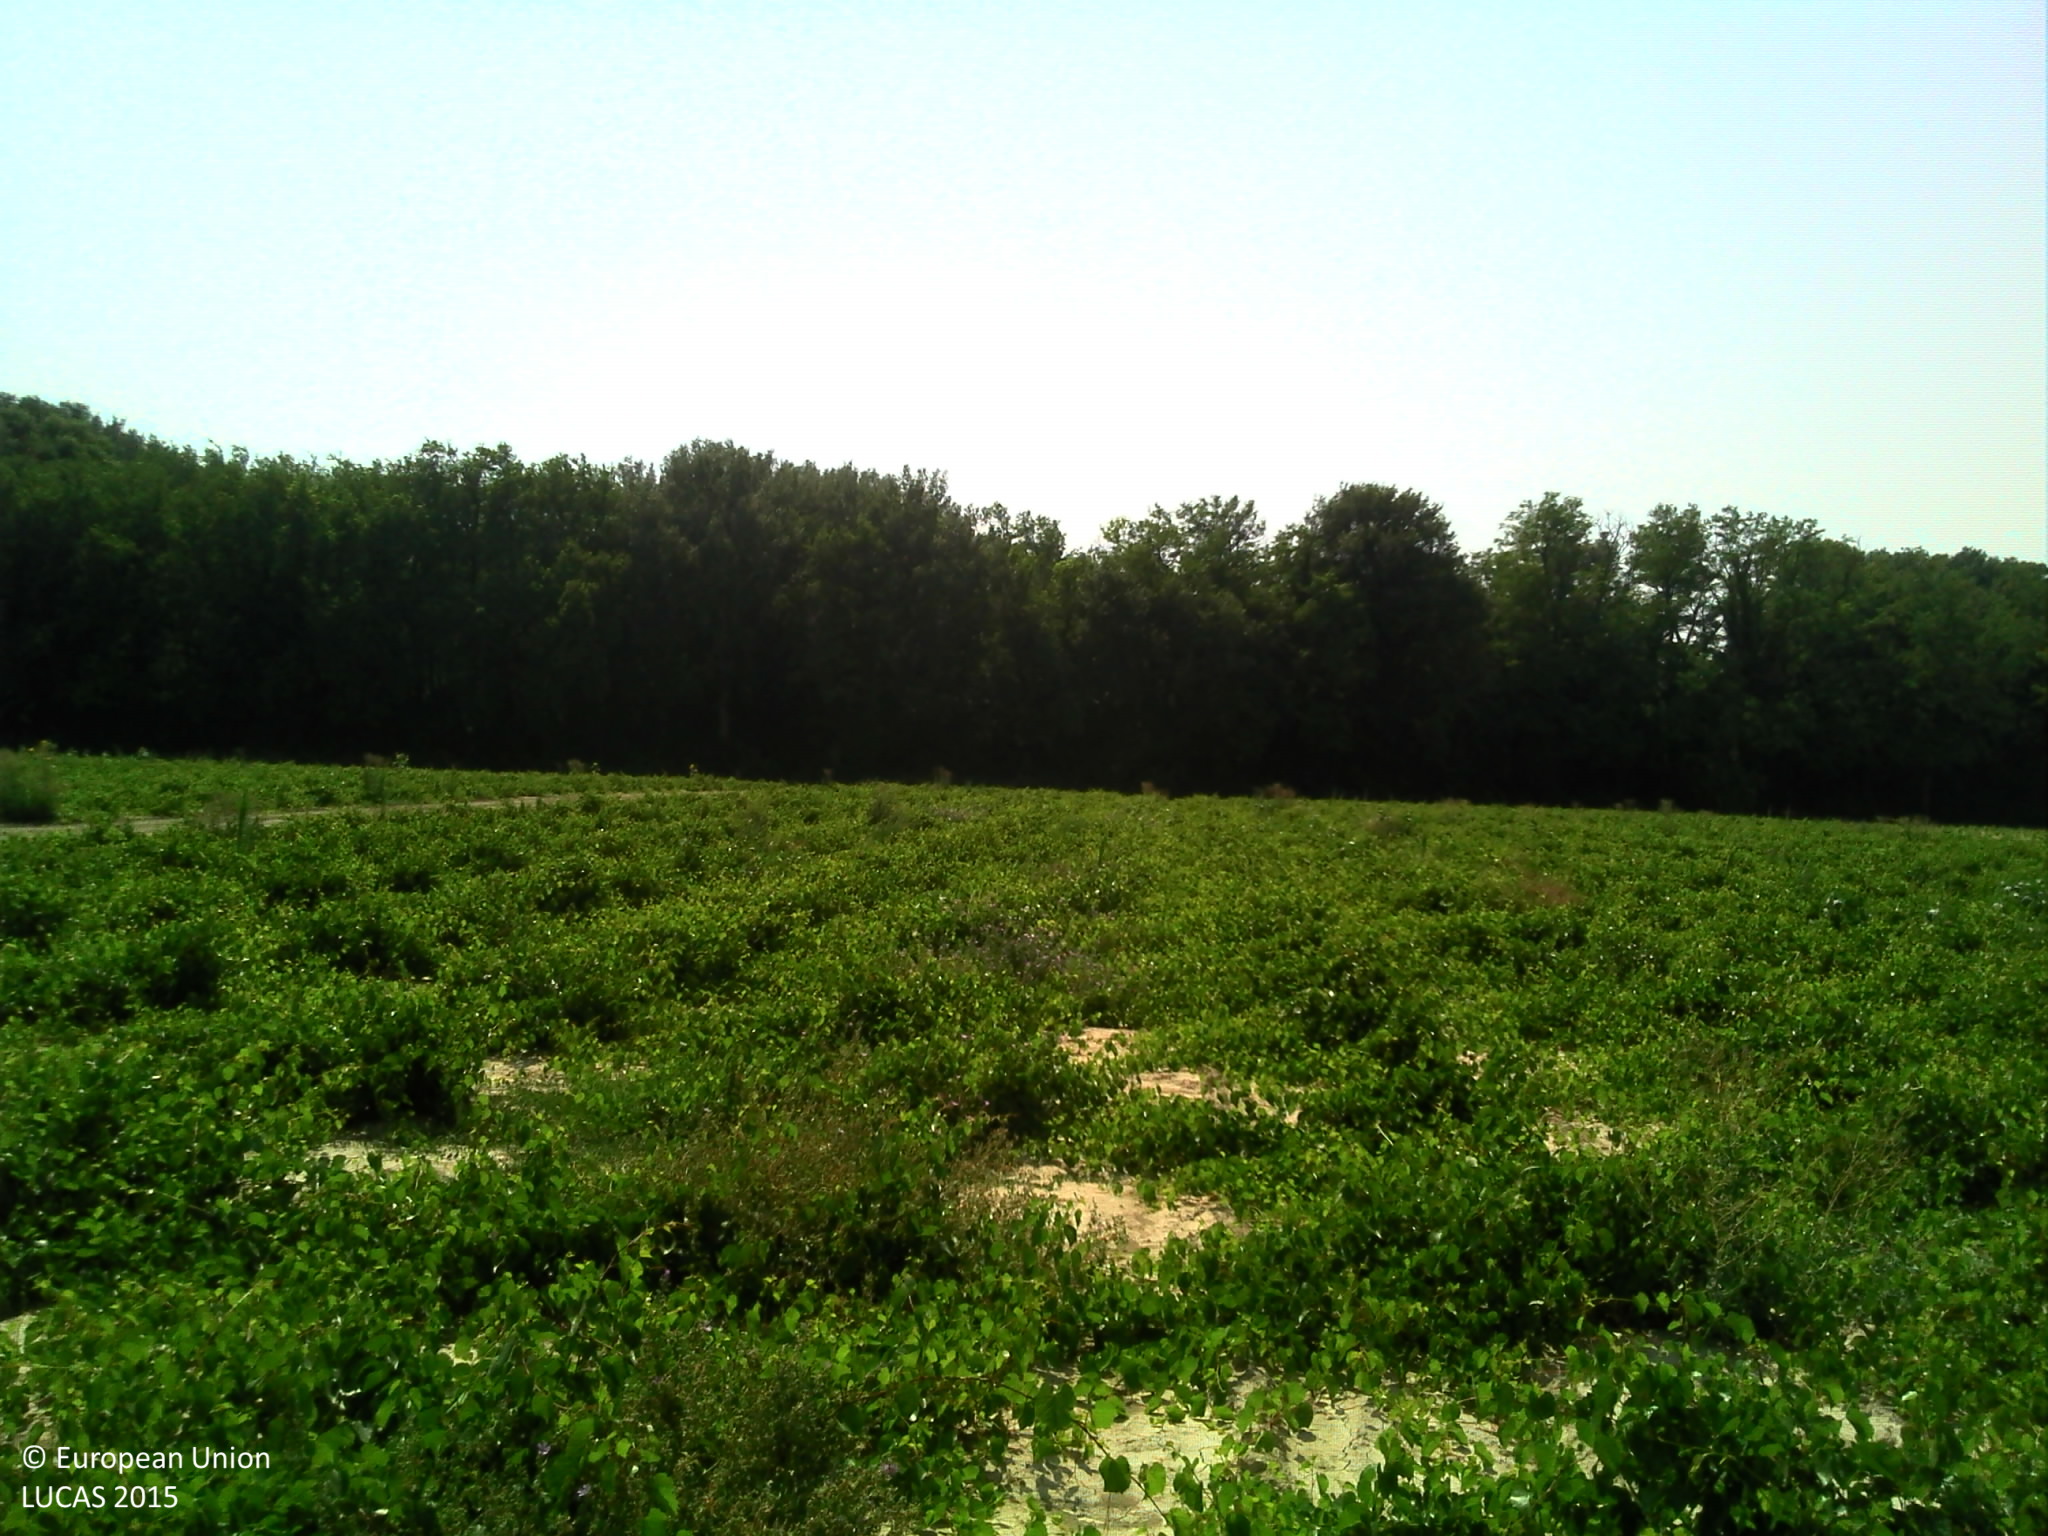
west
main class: Cropland
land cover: Nurseries
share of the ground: 50 - 75 %
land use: Agriculture (excluding fallow land and kitchen gardens)
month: July
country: FR
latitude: 44.2158
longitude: 4.7133
